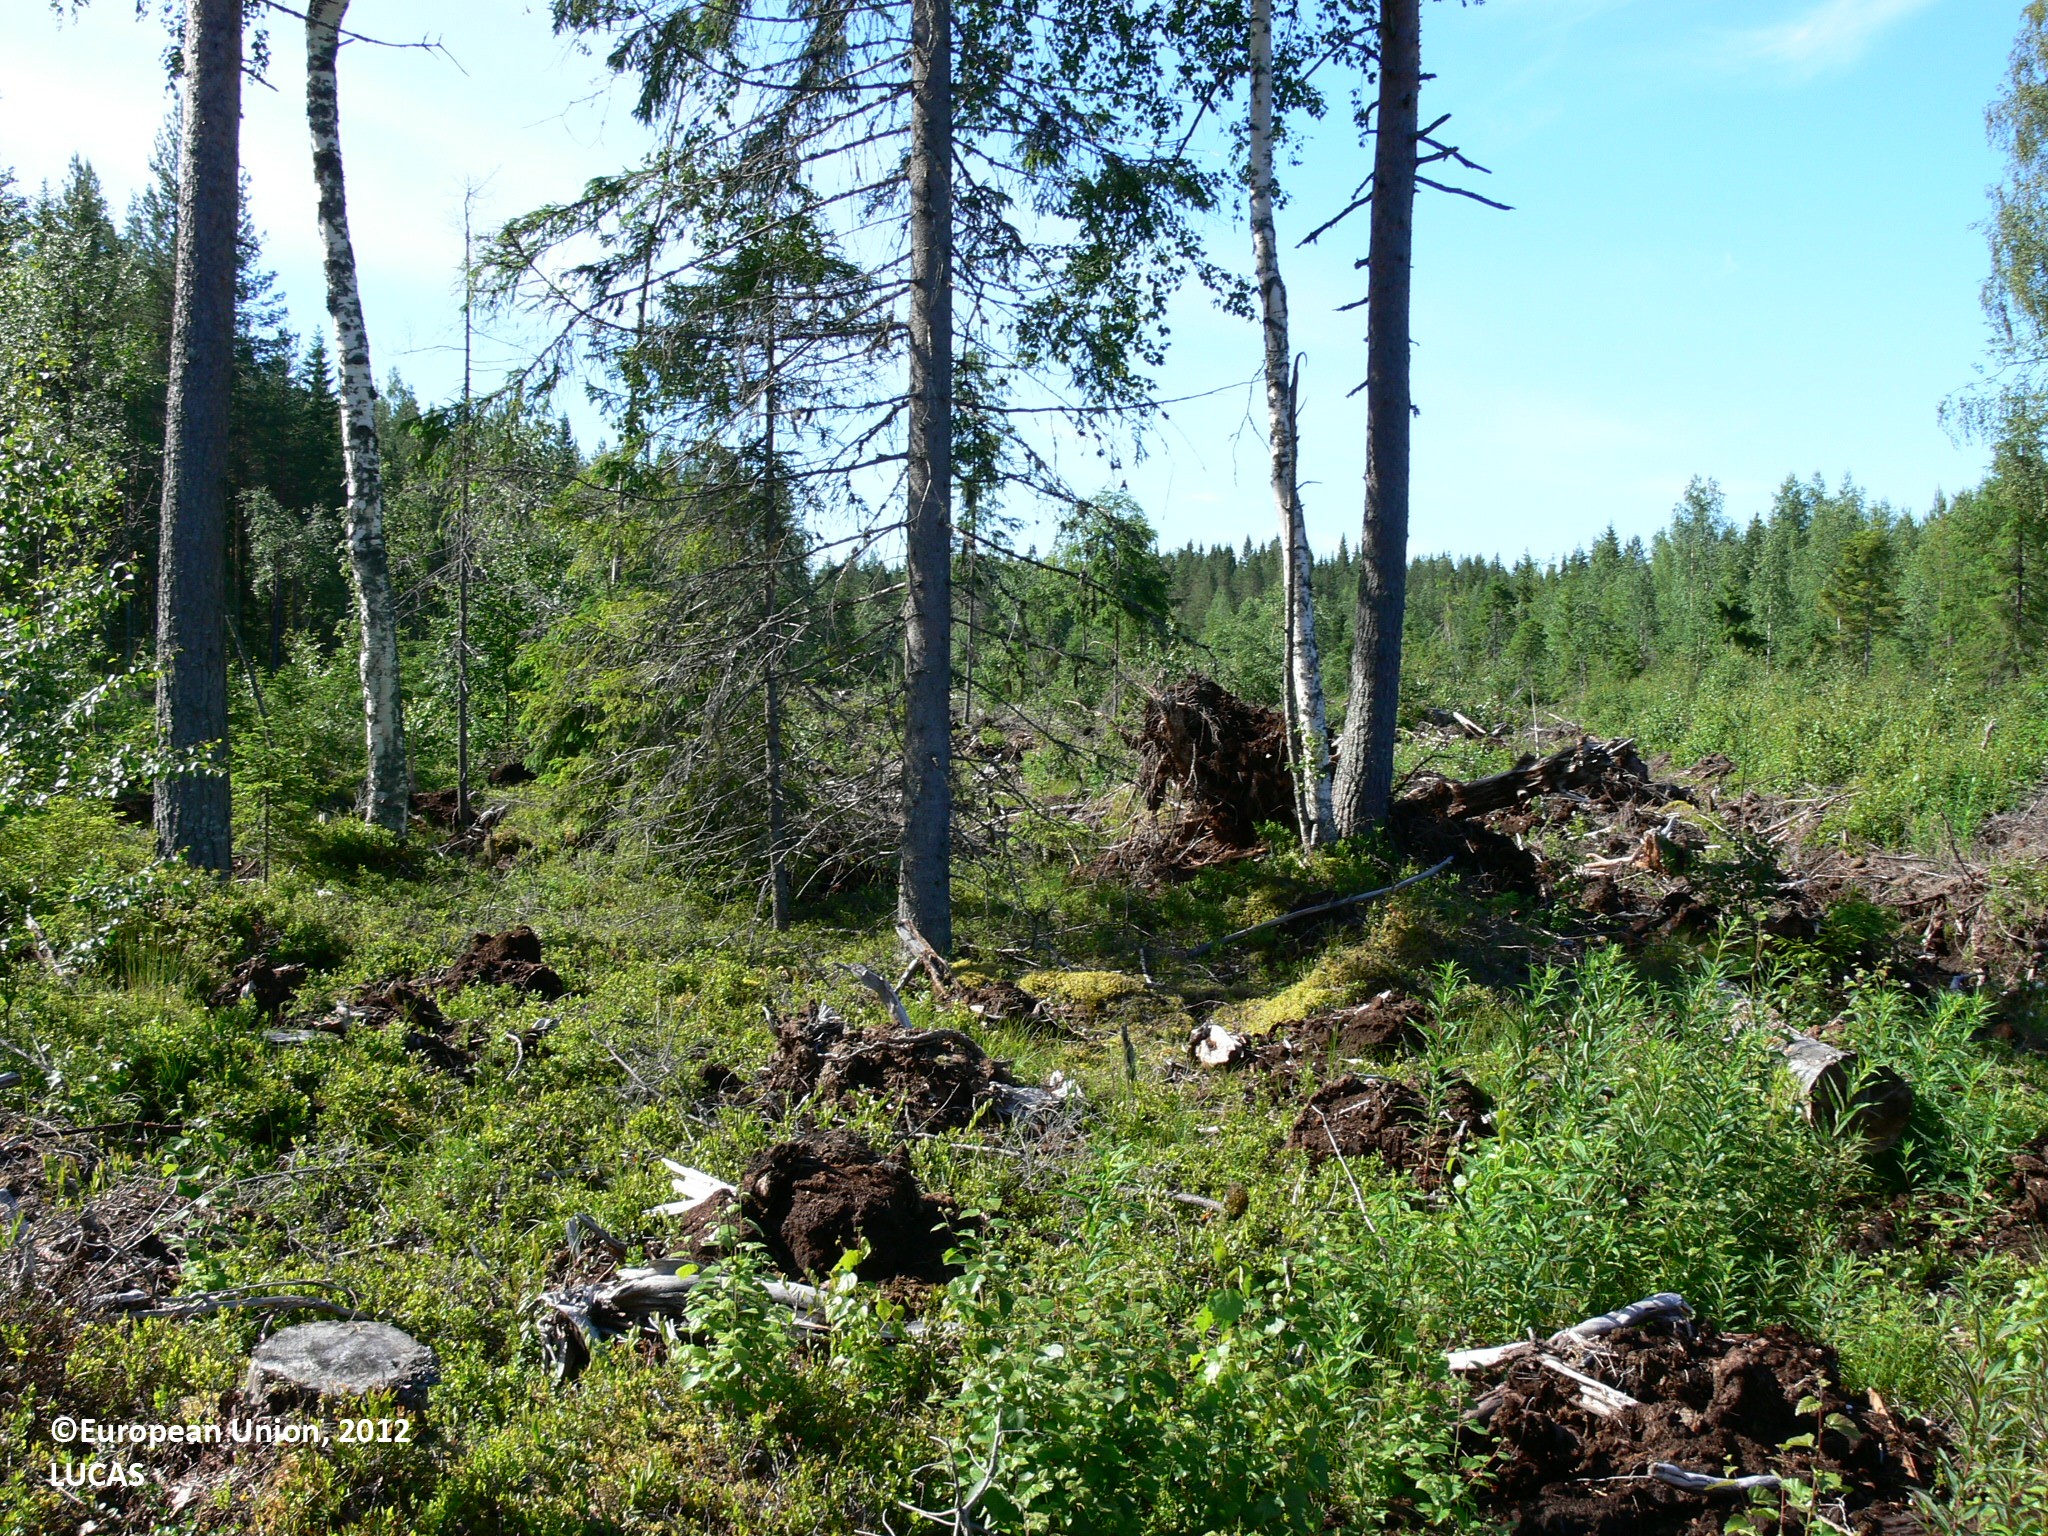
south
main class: Woodland
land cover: Broadleaved woodland
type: boreal forest
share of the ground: 10 - 25 %
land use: Forestry
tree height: < 5 m
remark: Clear cut
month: July
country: FI
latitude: 62.8896
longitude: 29.9013
